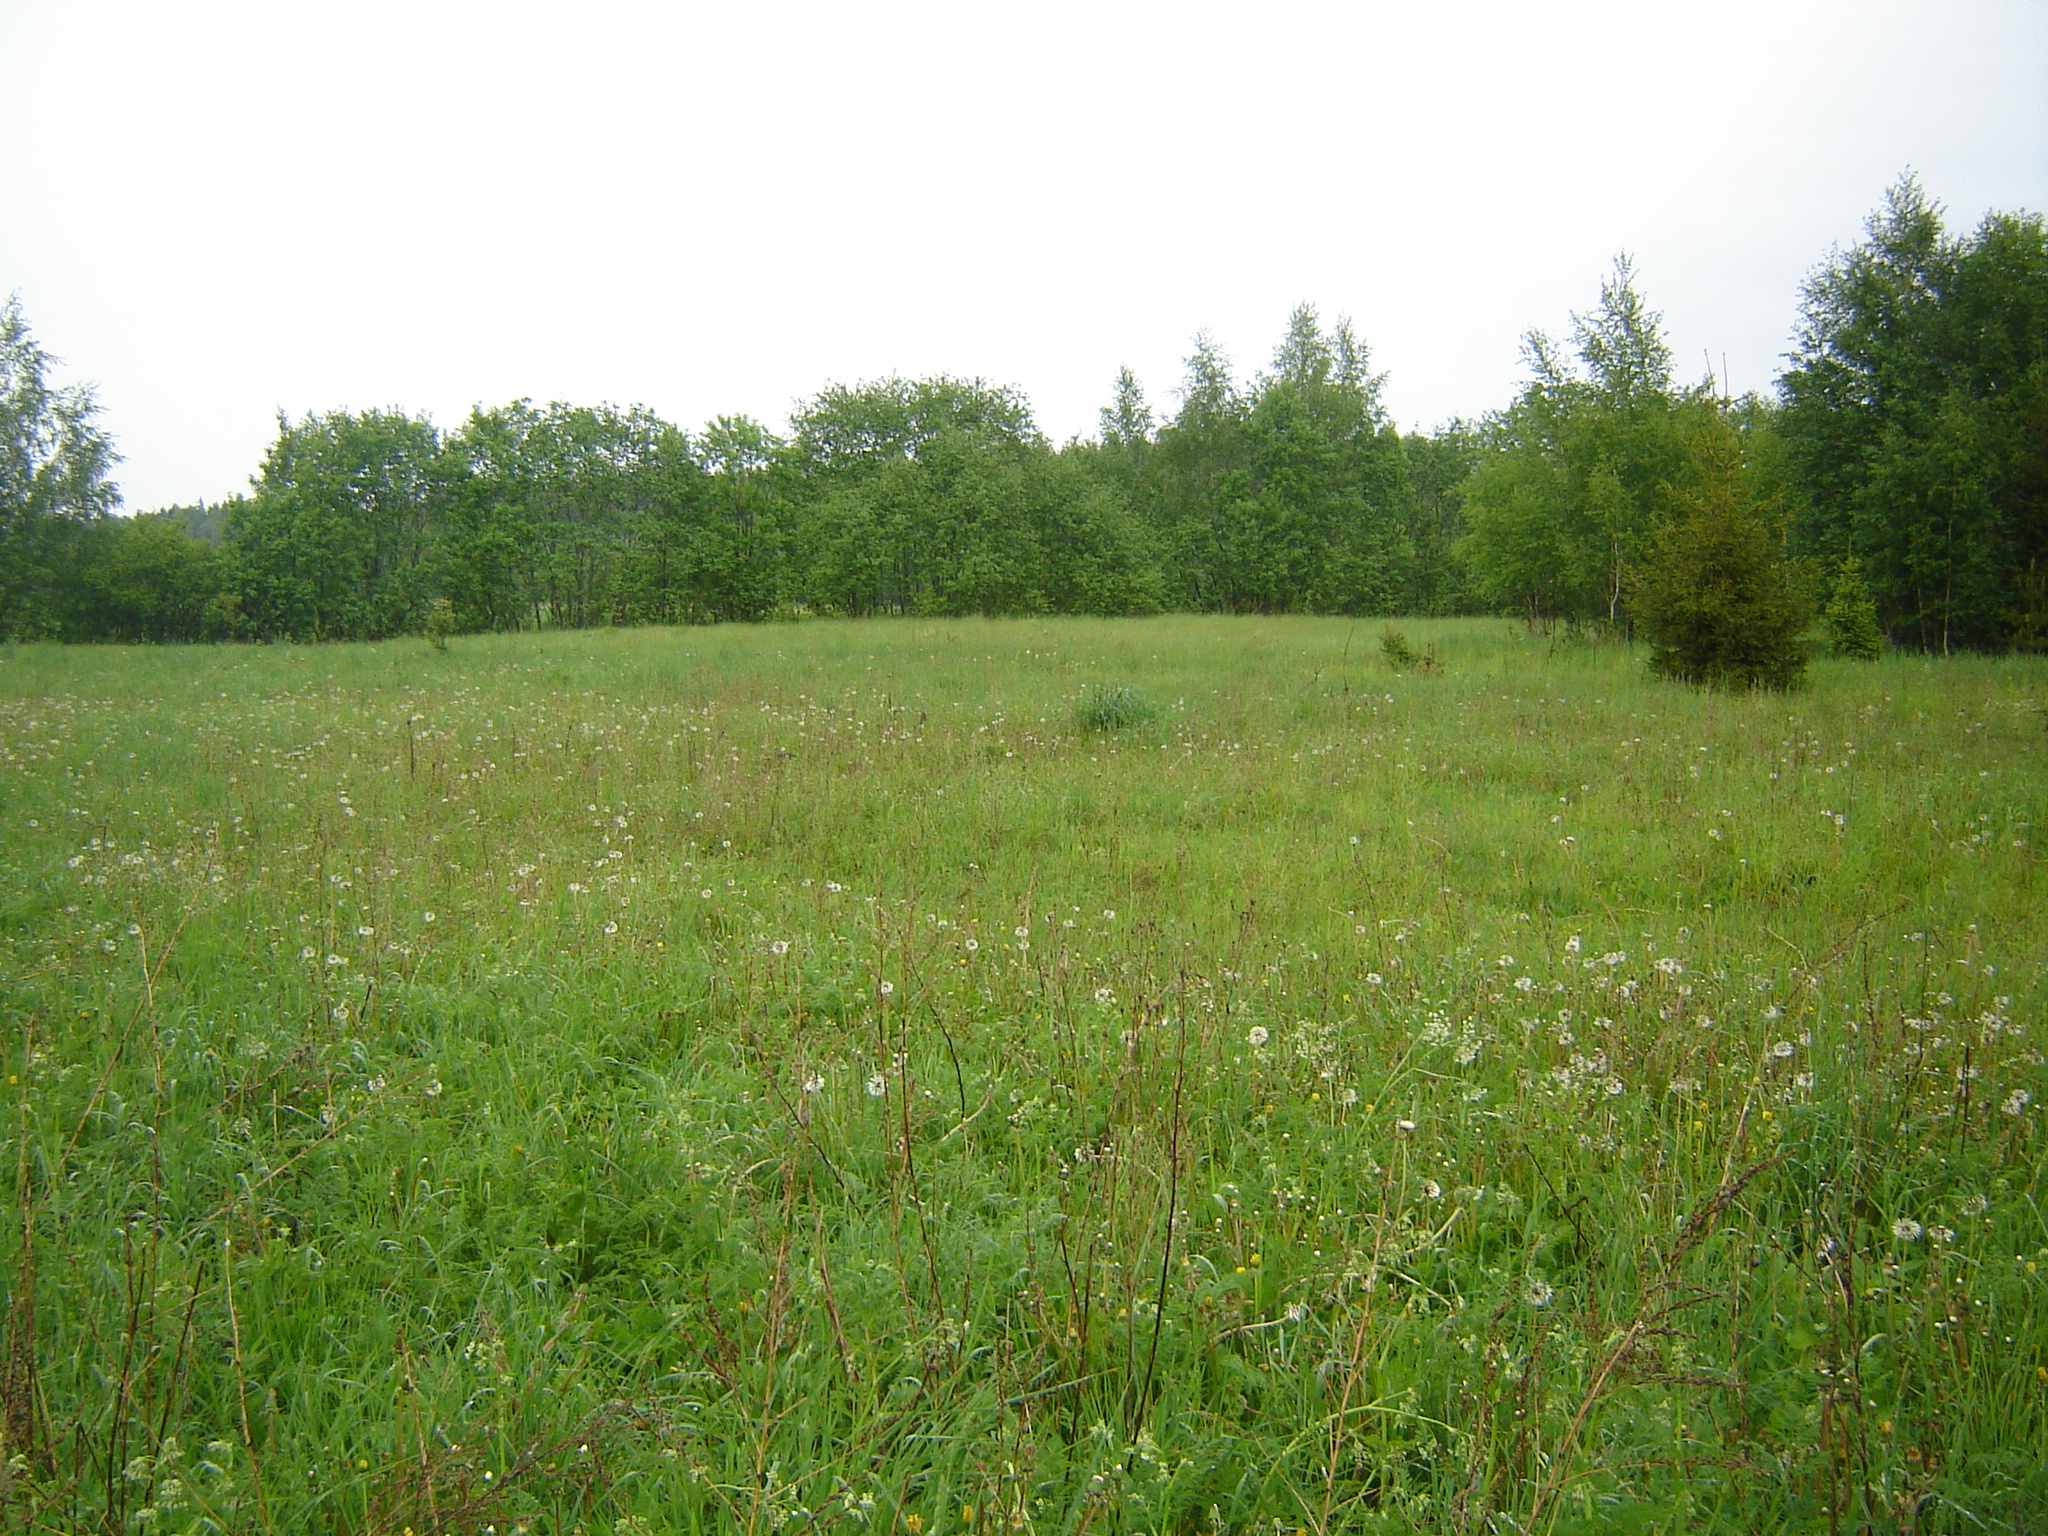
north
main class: Grassland
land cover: Grassland without tree/shrub cover
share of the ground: > 75 %
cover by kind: herbaceous plants 100 %
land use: Agriculture (excluding fallow land and kitchen gardens)
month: May
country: LT
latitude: 55.8946
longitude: 25.2276
